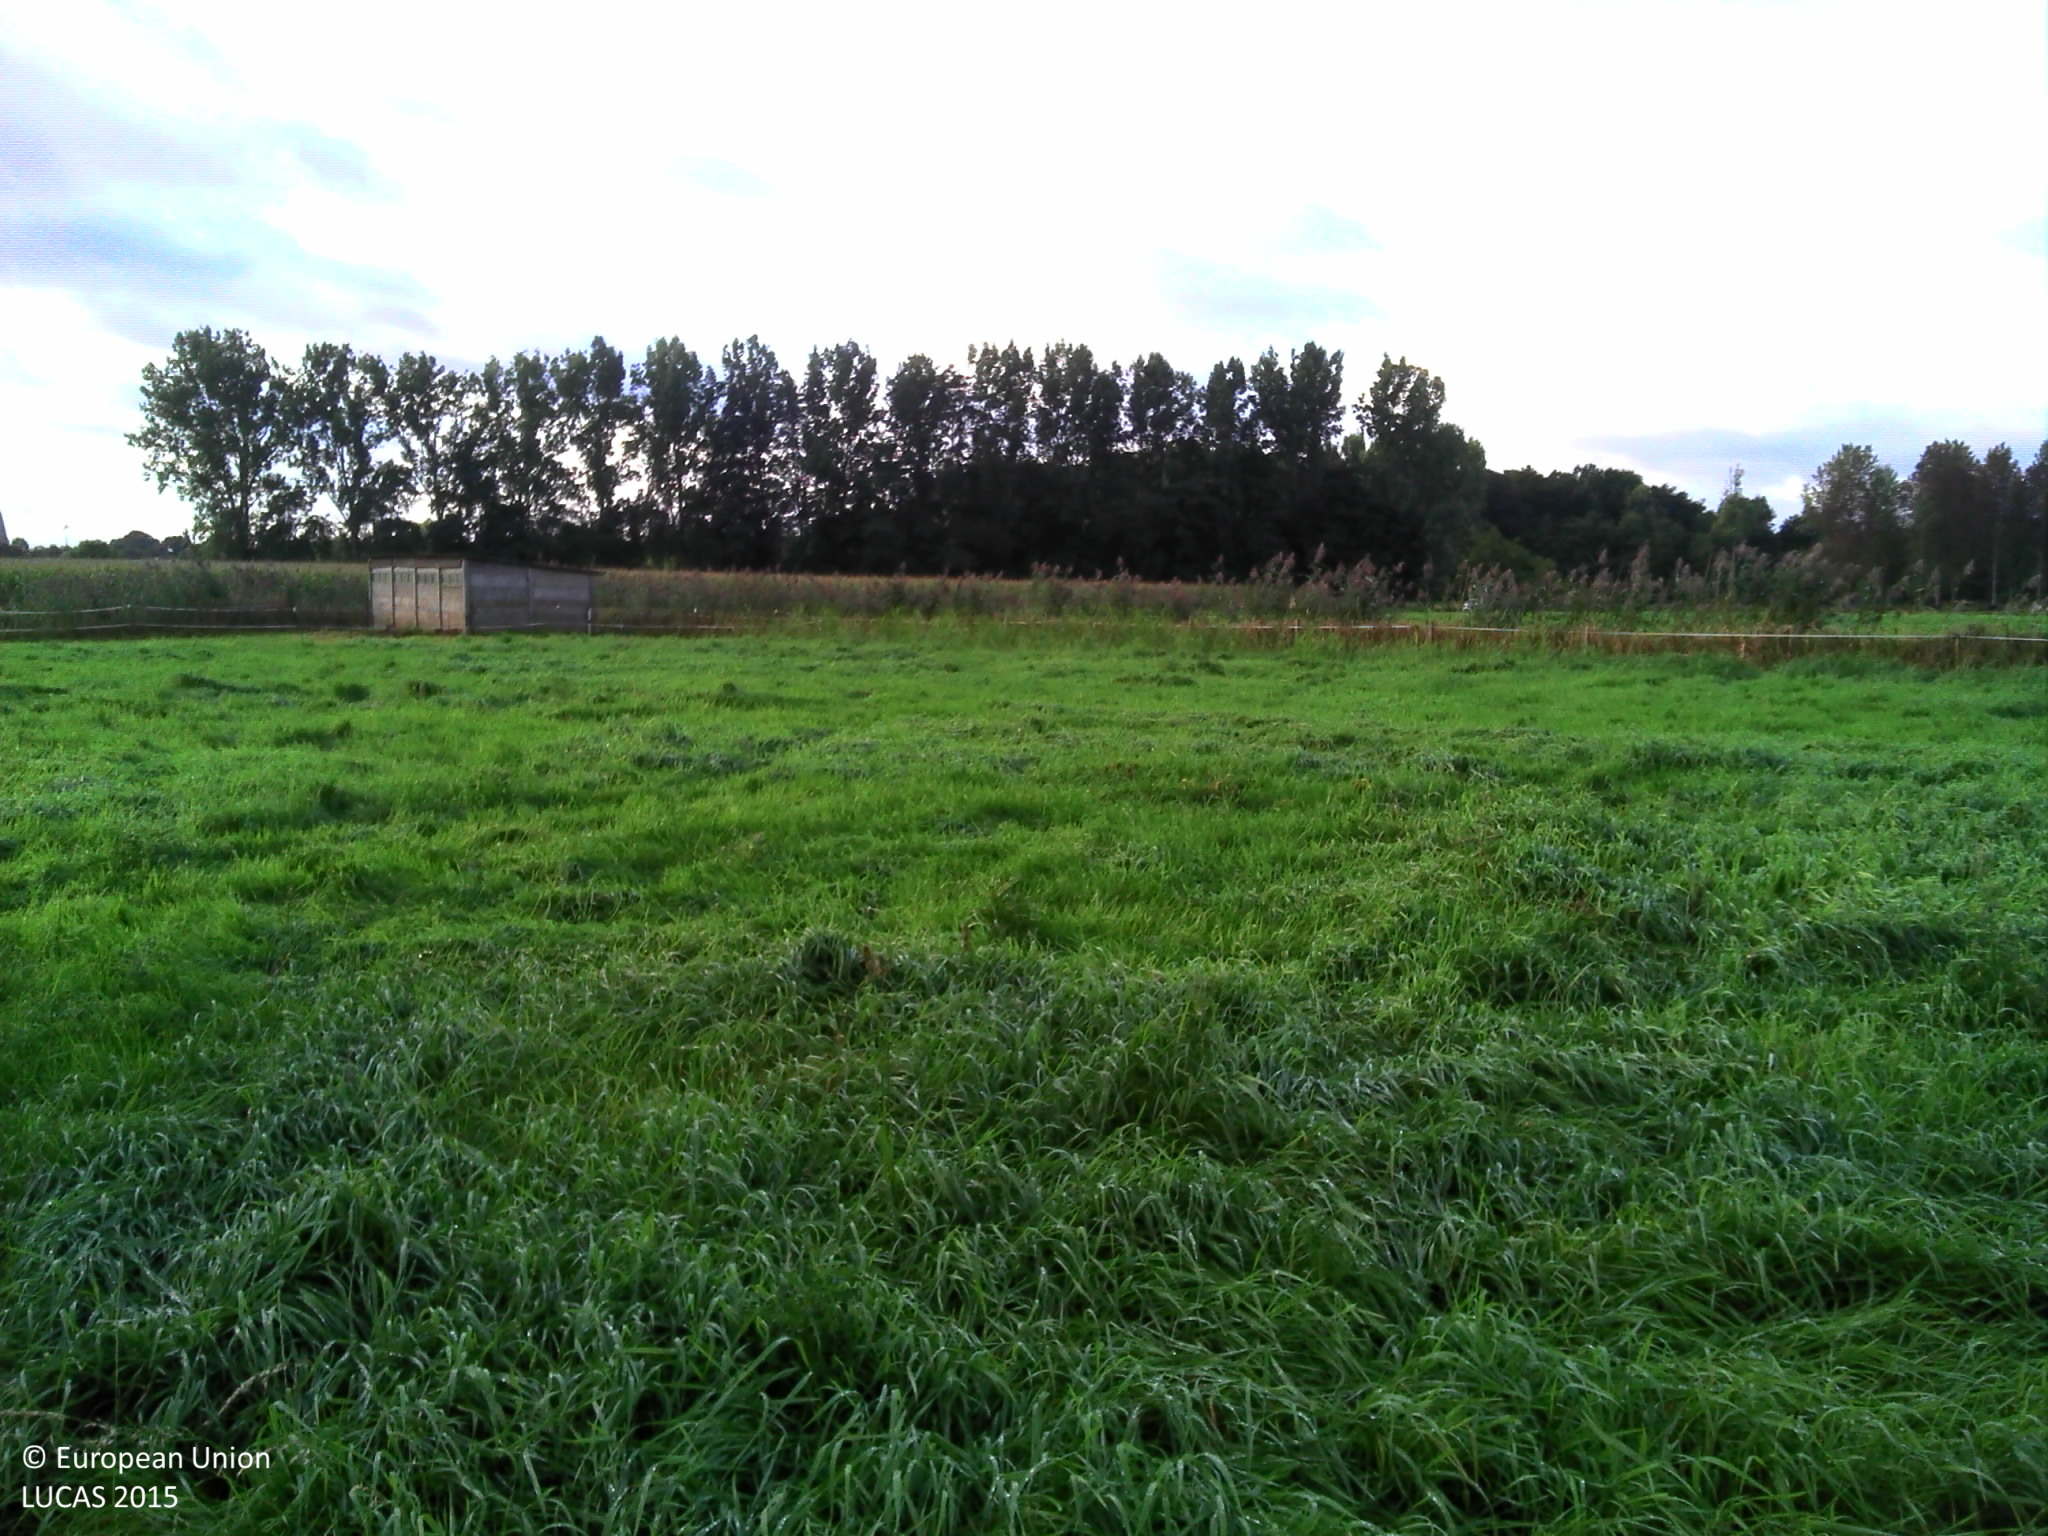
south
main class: Grassland
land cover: Grassland without tree/shrub cover
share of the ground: > 75 %
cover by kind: herbaceous plants 100 %
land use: Agriculture (excluding fallow land and kitchen gardens)
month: September
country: BE
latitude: 51.4094
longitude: 4.6336
